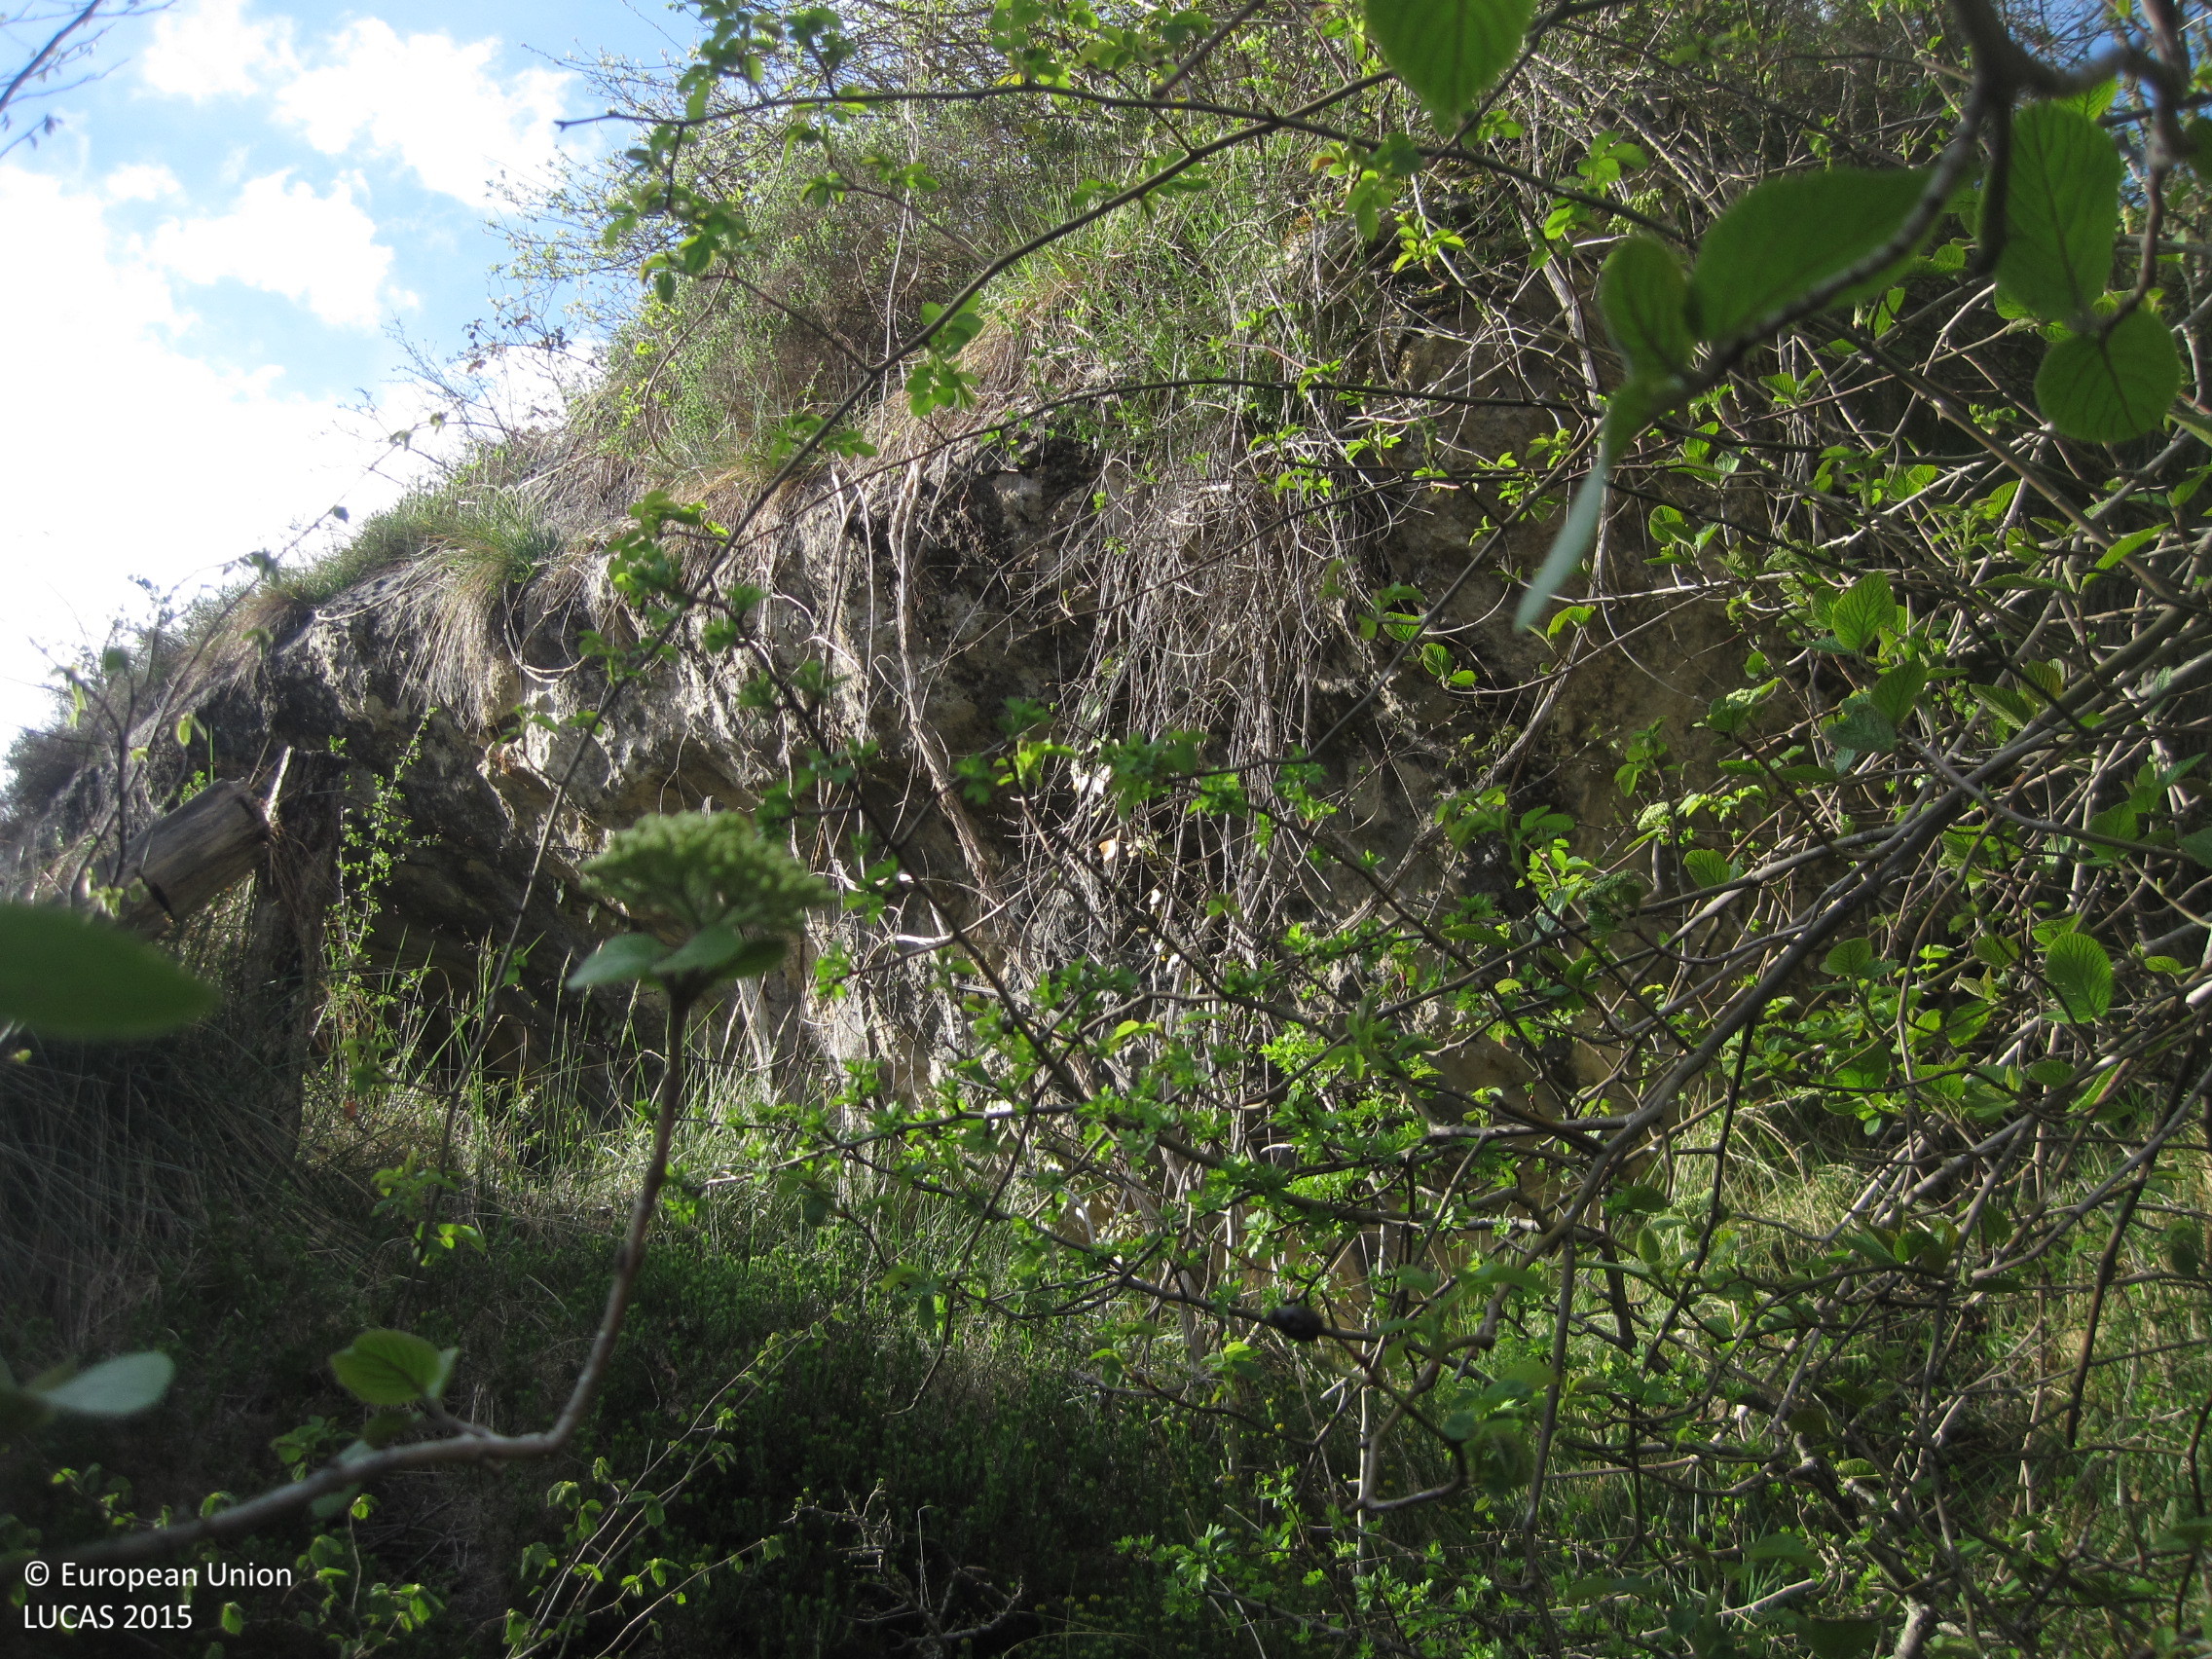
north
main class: Woodland
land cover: Broadleaved woodland
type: thermophilous deciduous forest
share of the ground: > 75 %
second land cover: Grassland without tree/shrub cover
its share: 25 - 50 %
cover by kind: broadleaved forest trees 40 %, shrubs 25 %, herbaceous plants 25 %, consolidated bare surface 10 %
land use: Forestry
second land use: Agriculture (excluding fallow land and kitchen gardens)
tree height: > 5 m
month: April
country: ES
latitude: 42.7822
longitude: -2.2570
